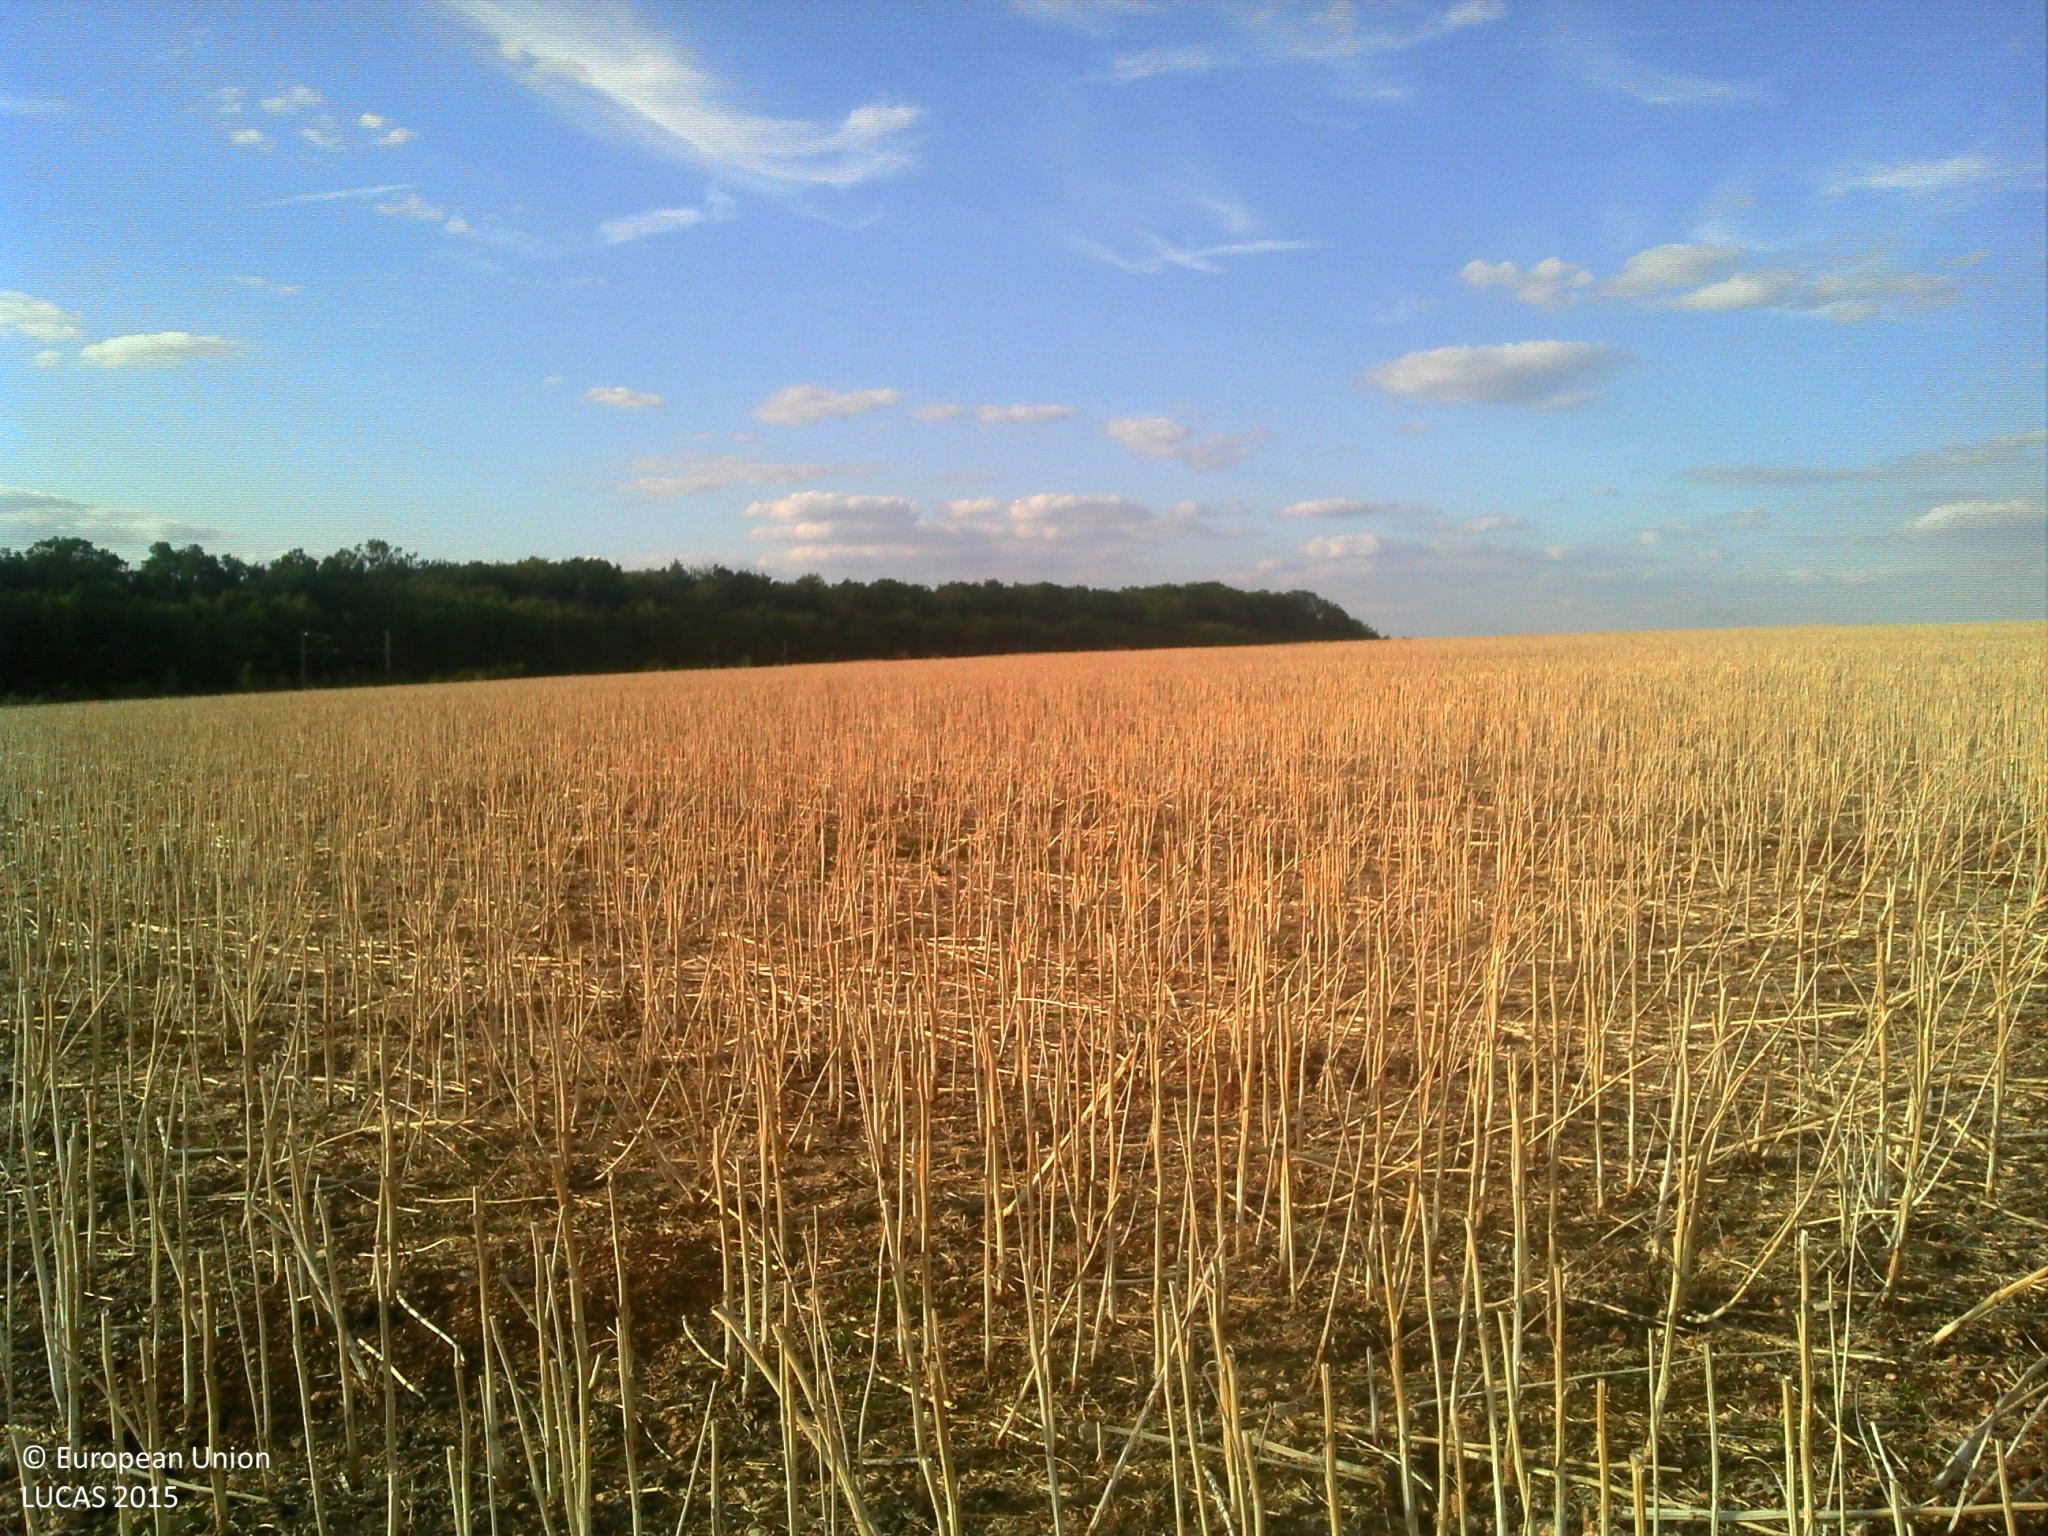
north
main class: Cropland
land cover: Rape and turnip rape
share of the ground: 10 - 25 %
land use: Agriculture (excluding fallow land and kitchen gardens)
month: July
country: FR
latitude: 47.5985
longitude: 5.2522
